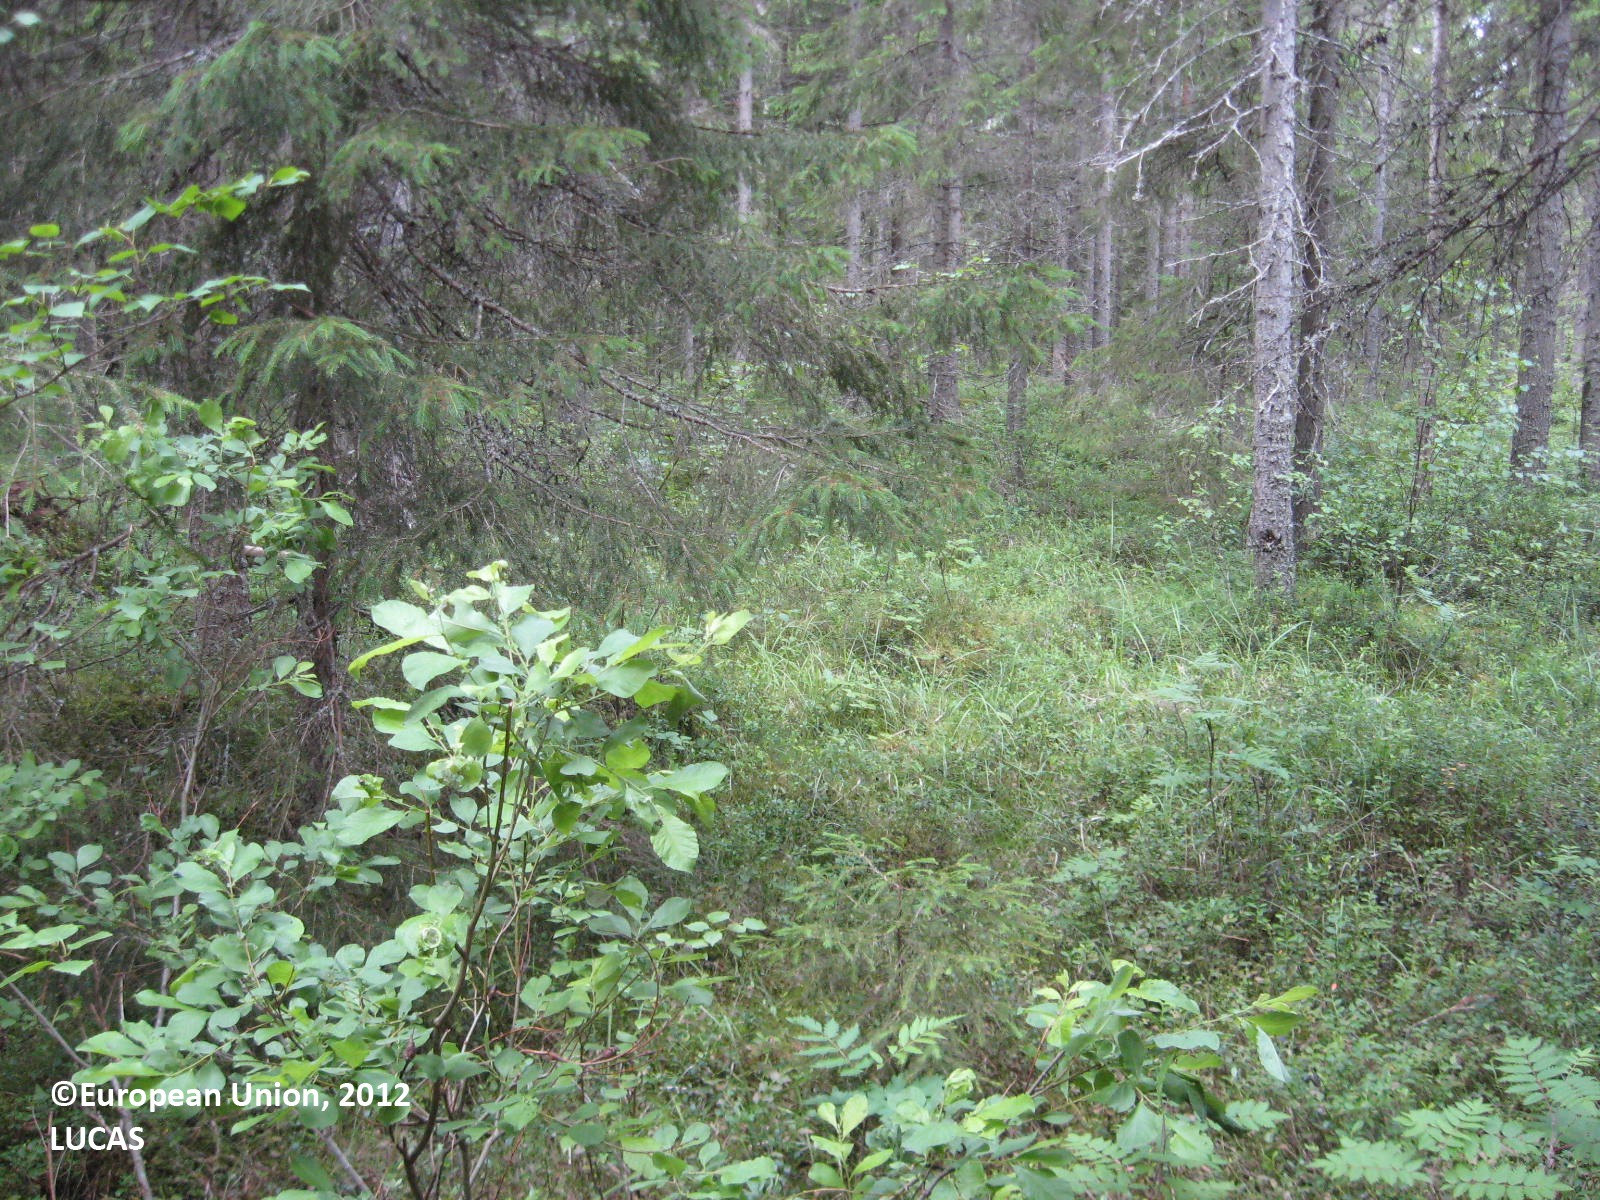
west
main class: Woodland
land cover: Spruce dominated coniferous woodland
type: boreal forest
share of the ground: > 75 %
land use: Forestry
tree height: > 5 m
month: July
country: FI
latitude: 62.5125
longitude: 21.5604
